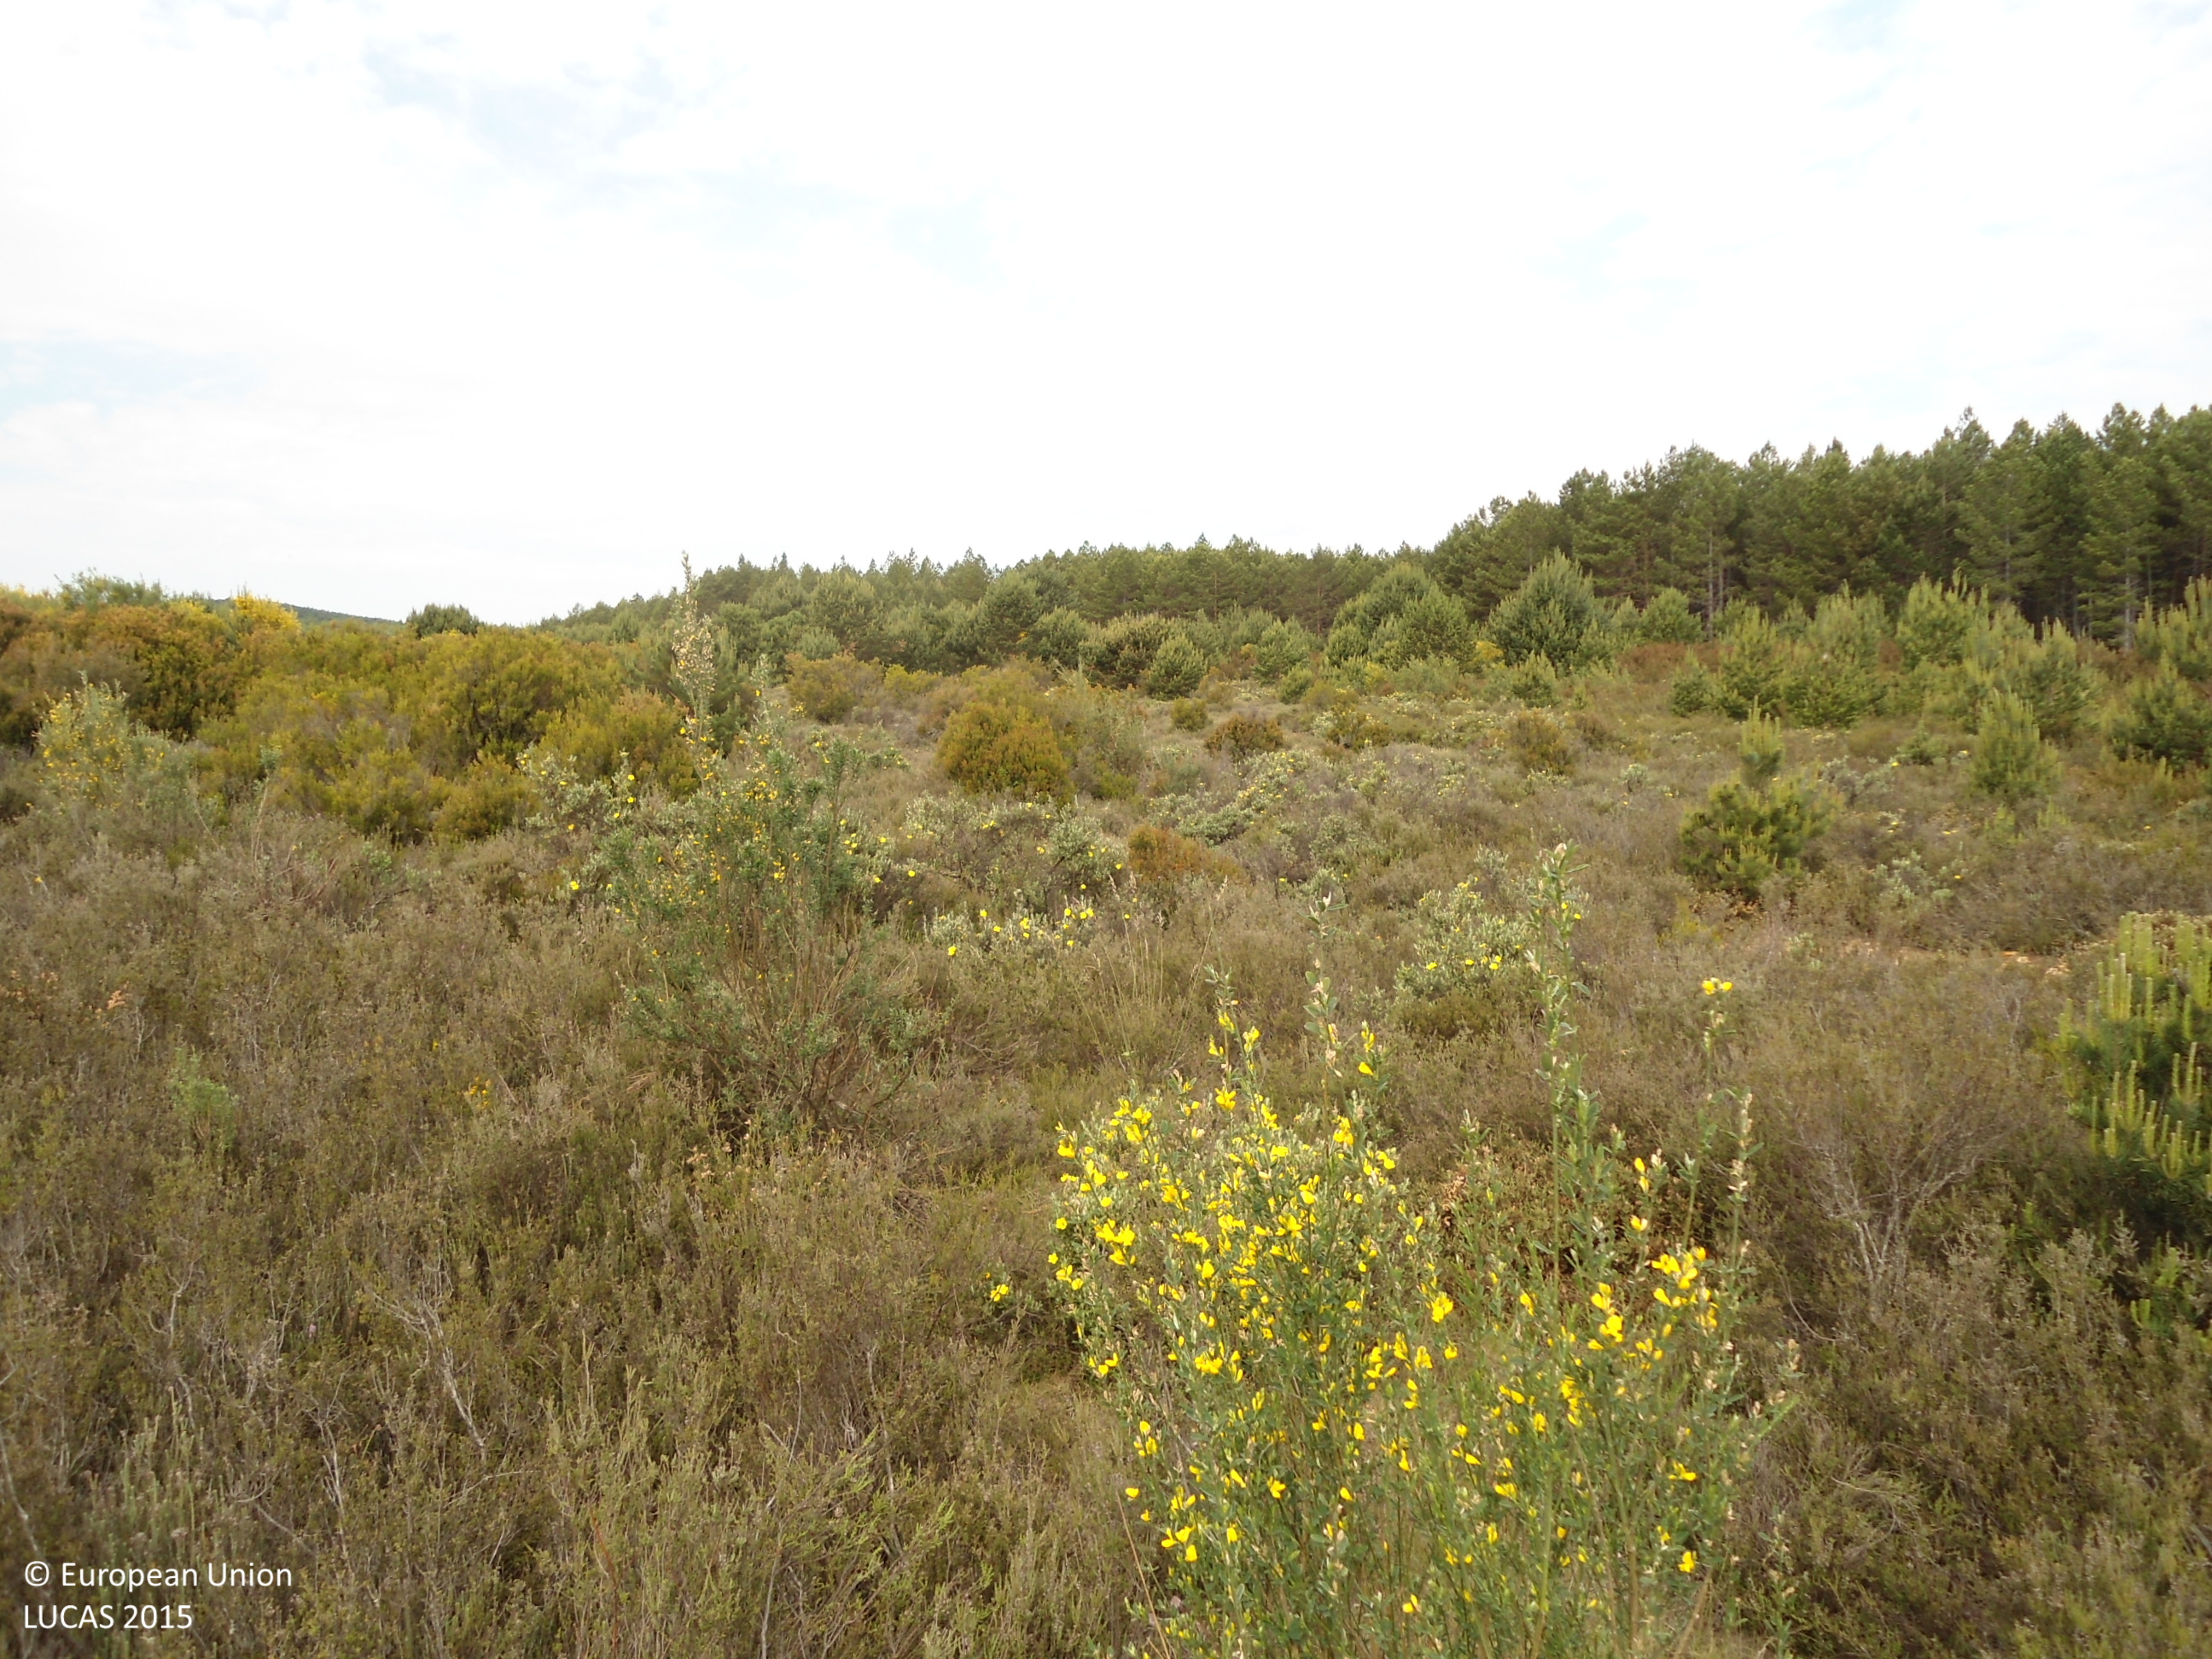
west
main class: Woodland
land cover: Pine dominated coniferous woodland
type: coniferous forest of the mediterranean region
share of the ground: 25 - 50 %
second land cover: Shrubland without tree cover
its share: 50 - 75 %
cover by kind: shrubs 70 %, coniferous forest trees 25 %, herbaceous plants 5 %
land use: Forestry
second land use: Community services
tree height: < 5 m
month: June
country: ES
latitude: 41.9827
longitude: -6.5371
